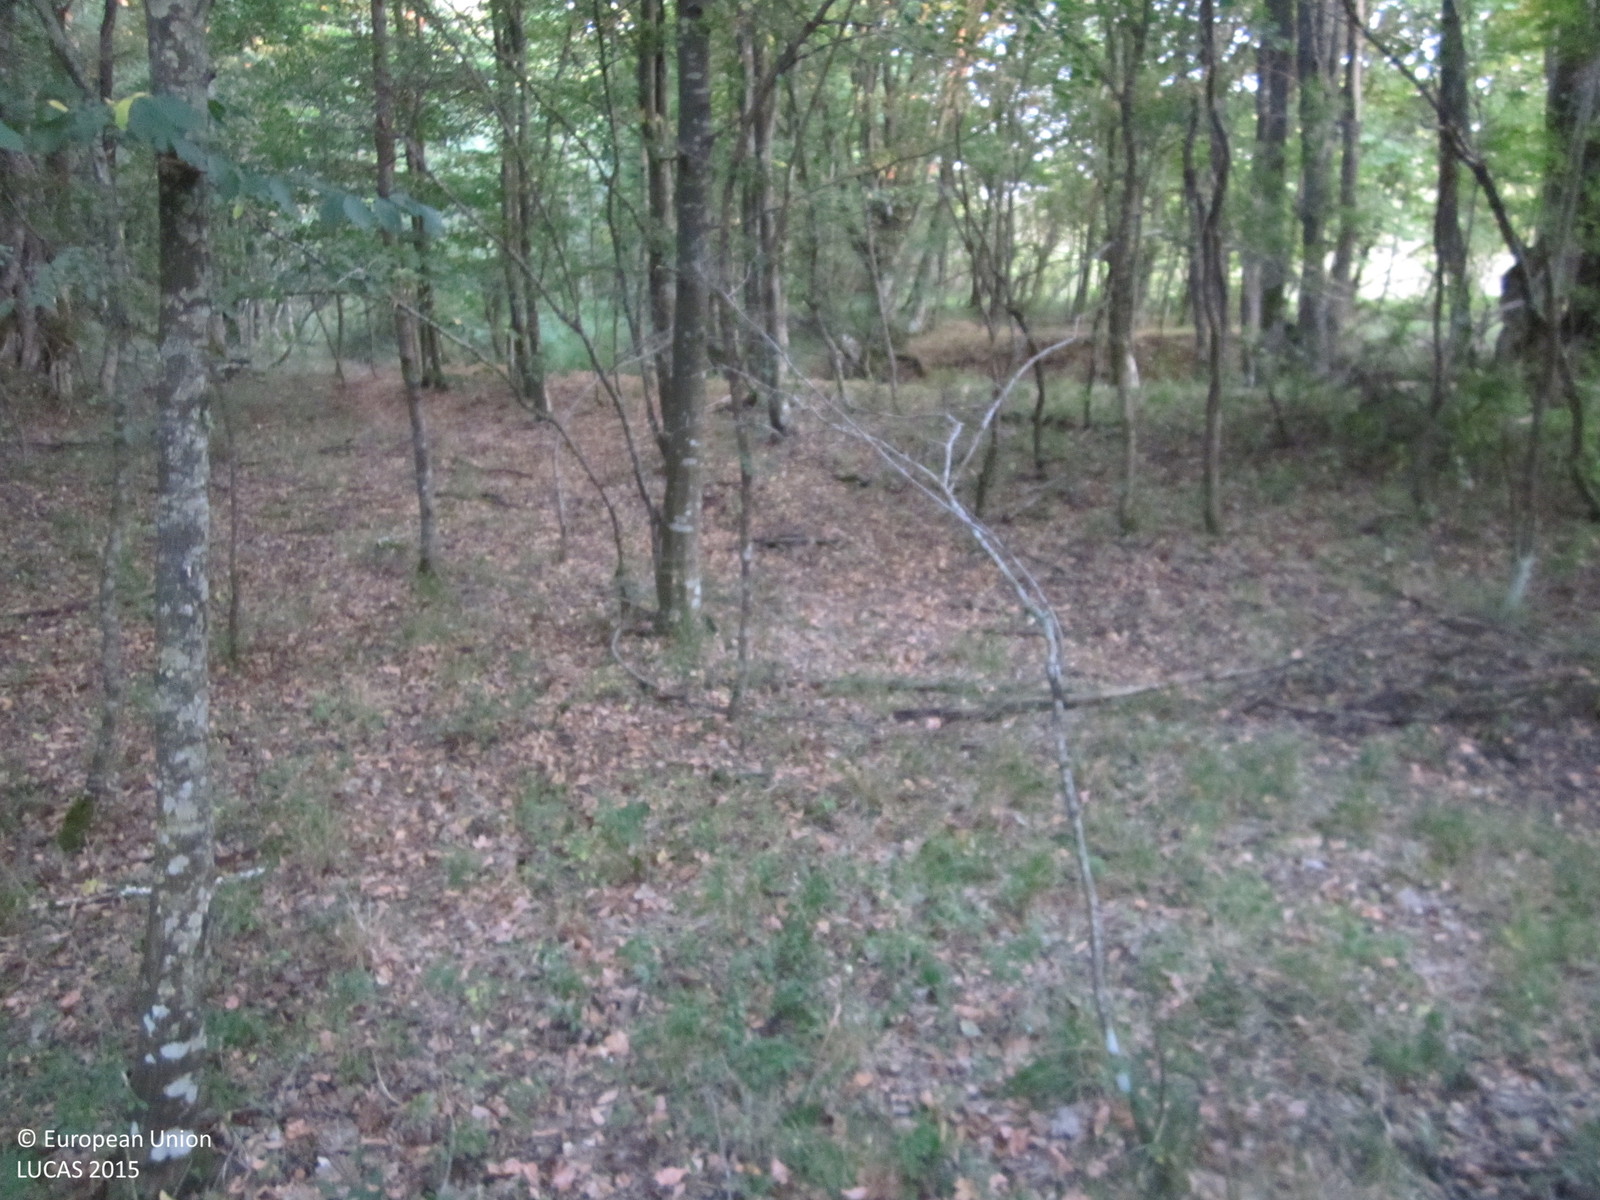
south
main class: Woodland
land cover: Broadleaved woodland
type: thermophilous deciduous forest
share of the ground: > 75 %
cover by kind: broadleaved forest trees 90 %, unconsolidated bare surface 10 %
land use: Forestry
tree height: > 5 m
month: August
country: BG
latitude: 41.9741
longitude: 27.5498
